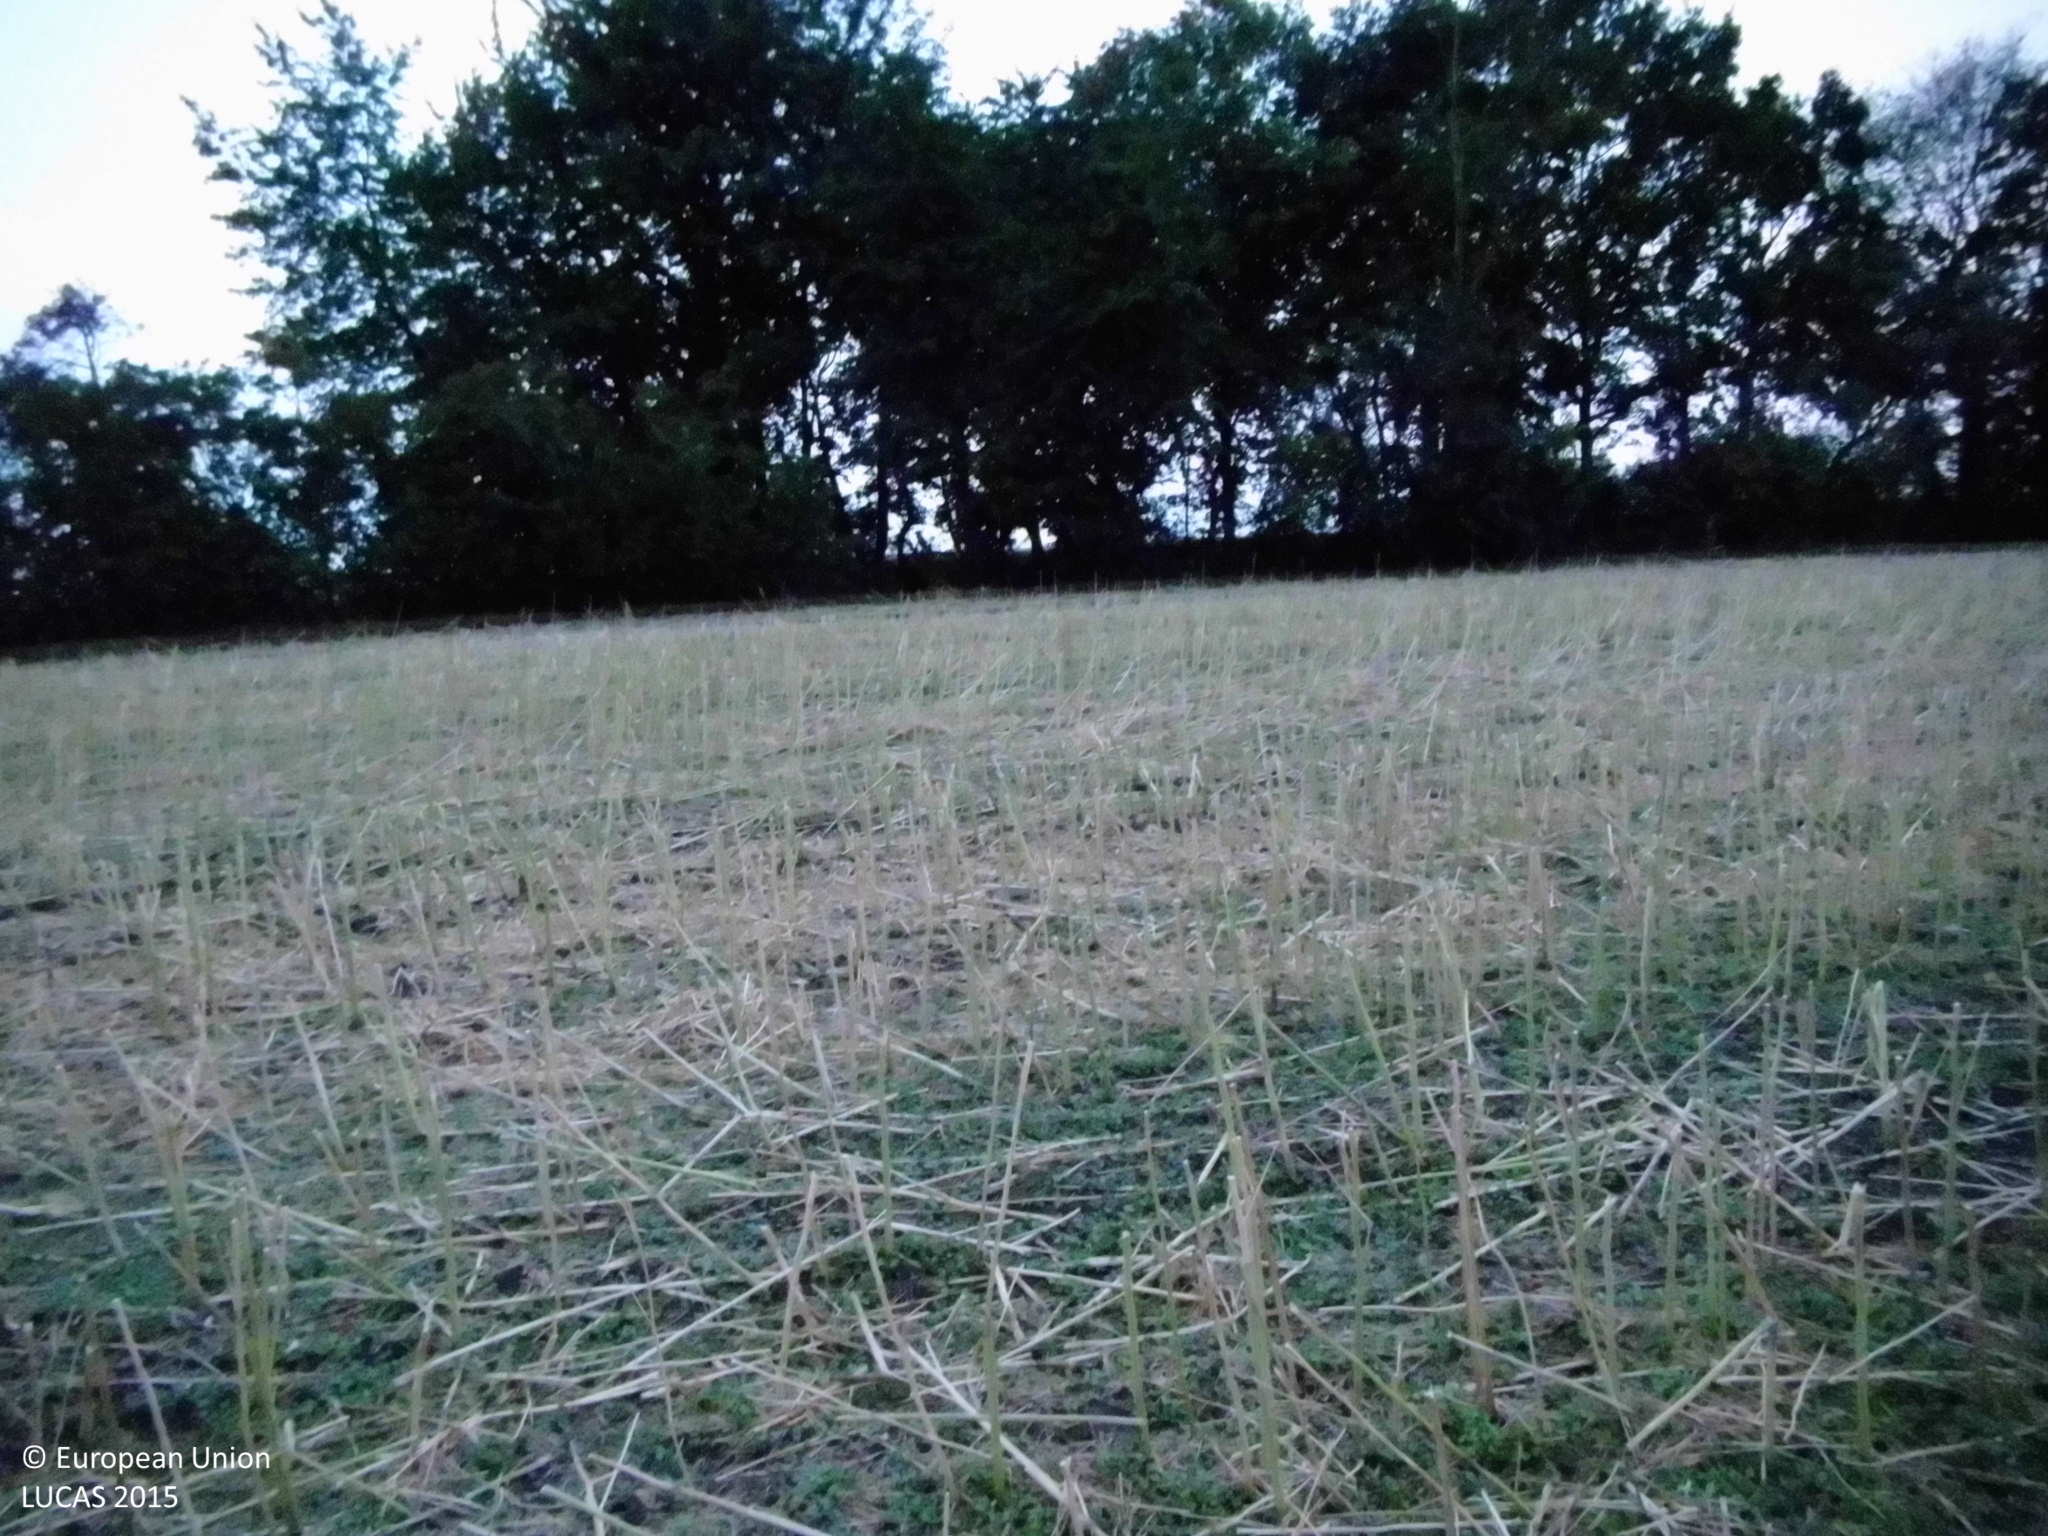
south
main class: Cropland
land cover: Rape and turnip rape
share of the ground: > 75 %
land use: Agriculture (excluding fallow land and kitchen gardens)
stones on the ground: < 10 %
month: August
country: DE
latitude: 50.5354
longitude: 8.6036
